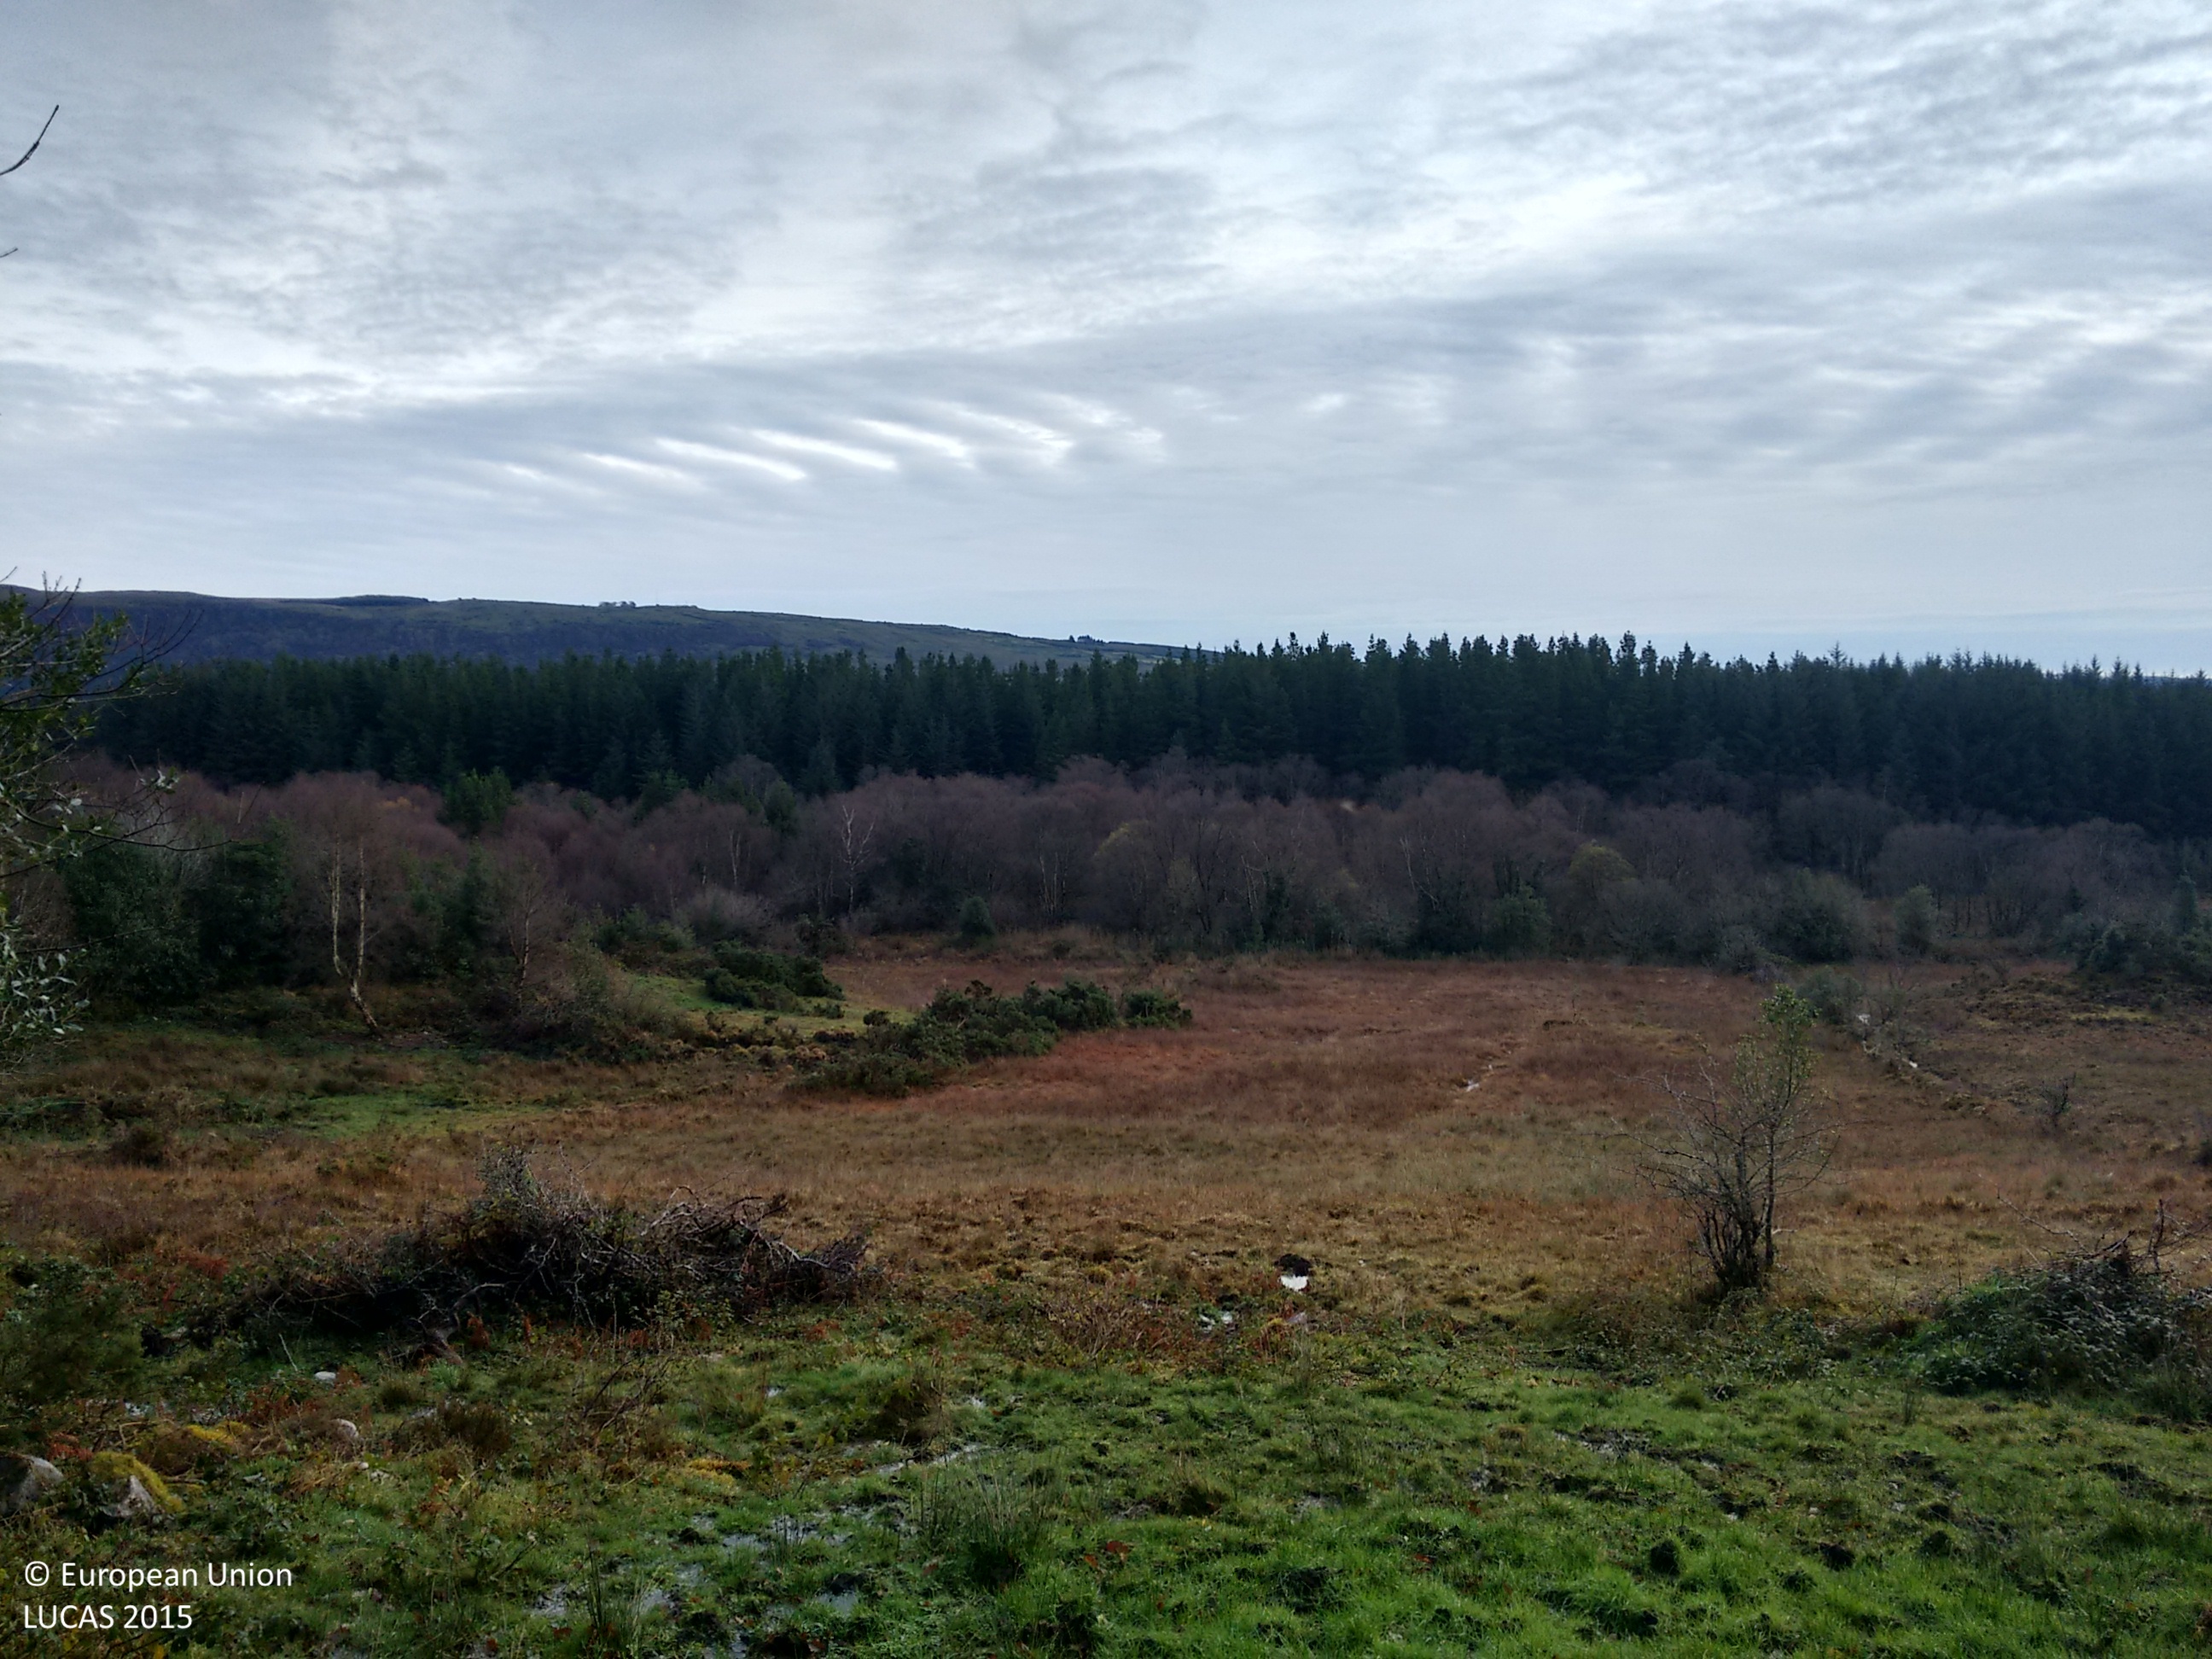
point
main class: Woodland
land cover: Spruce dominated coniferous woodland
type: exotic forest
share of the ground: > 75 %
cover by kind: coniferous forest trees 100 %
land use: Forestry
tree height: > 5 m
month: November
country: IE
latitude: 54.2732
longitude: -8.2254
